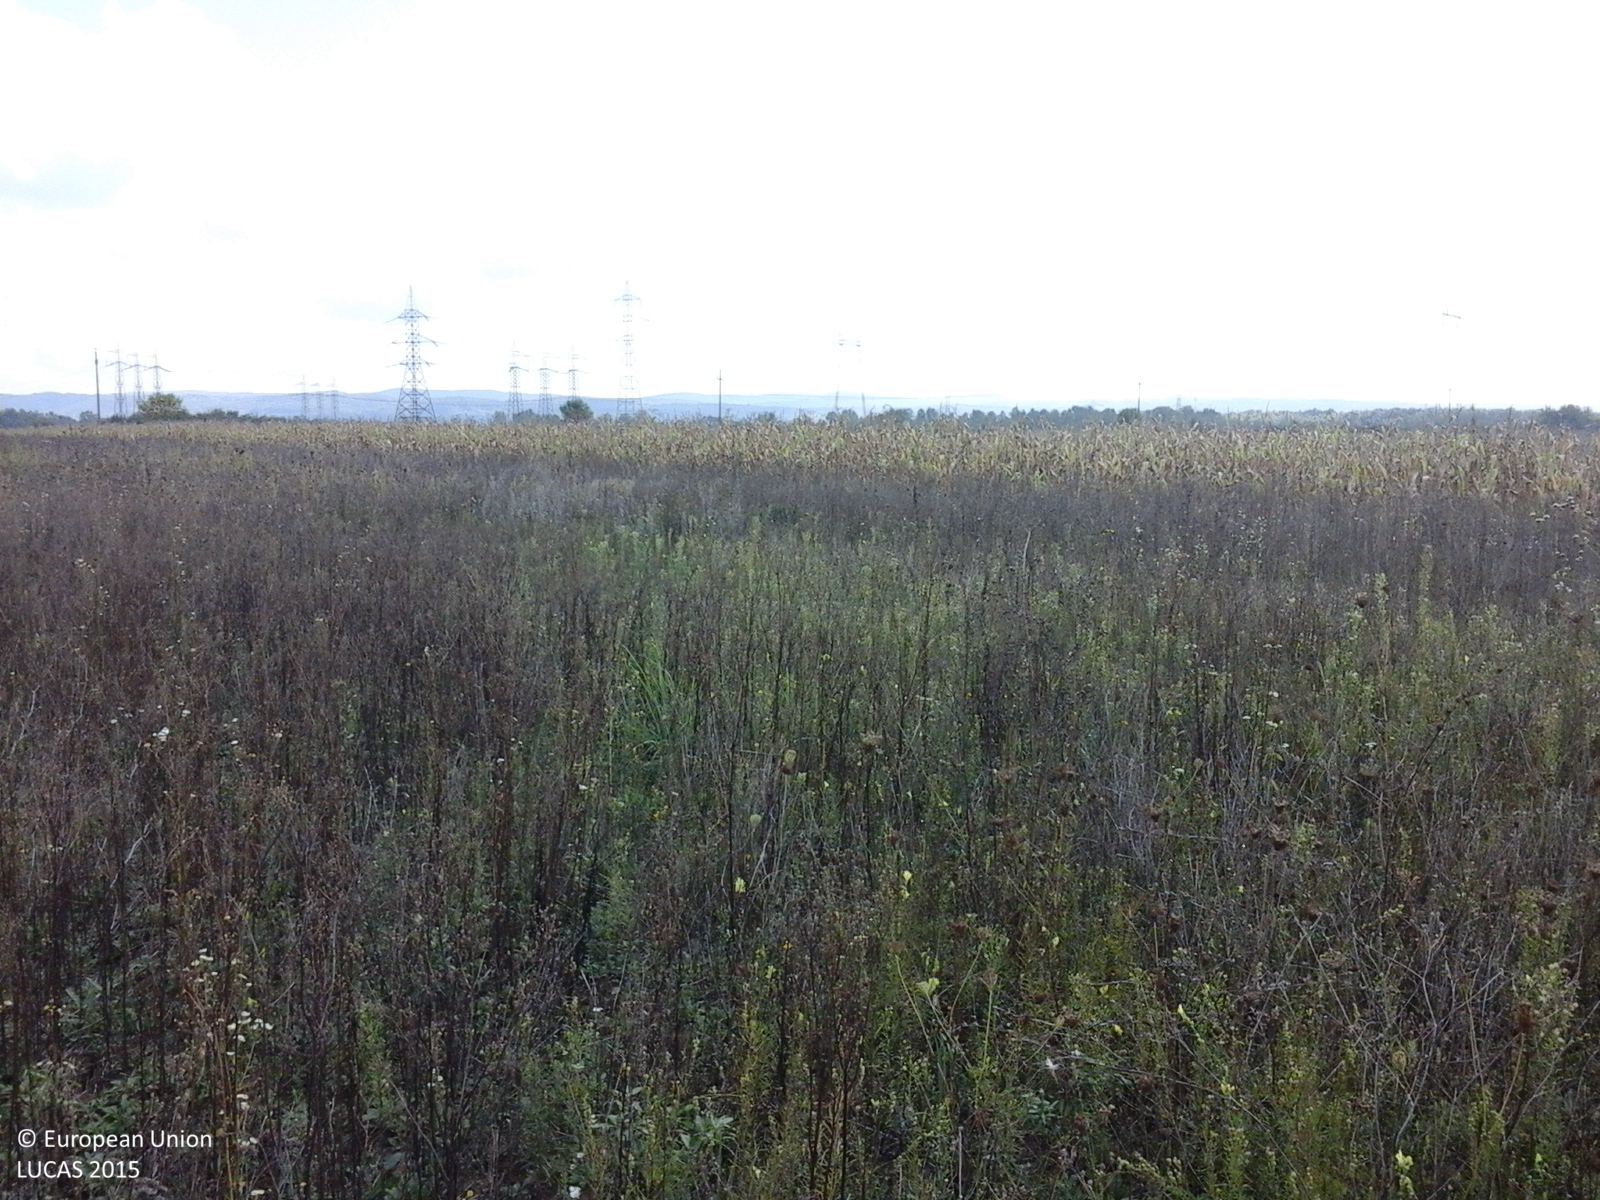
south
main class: Grassland
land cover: Spontaneously vegetated surfaces
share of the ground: > 75 %
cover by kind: herbaceous plants 100 %
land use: Fallow land
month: September
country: RO
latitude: 45.0134
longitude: 23.5206
